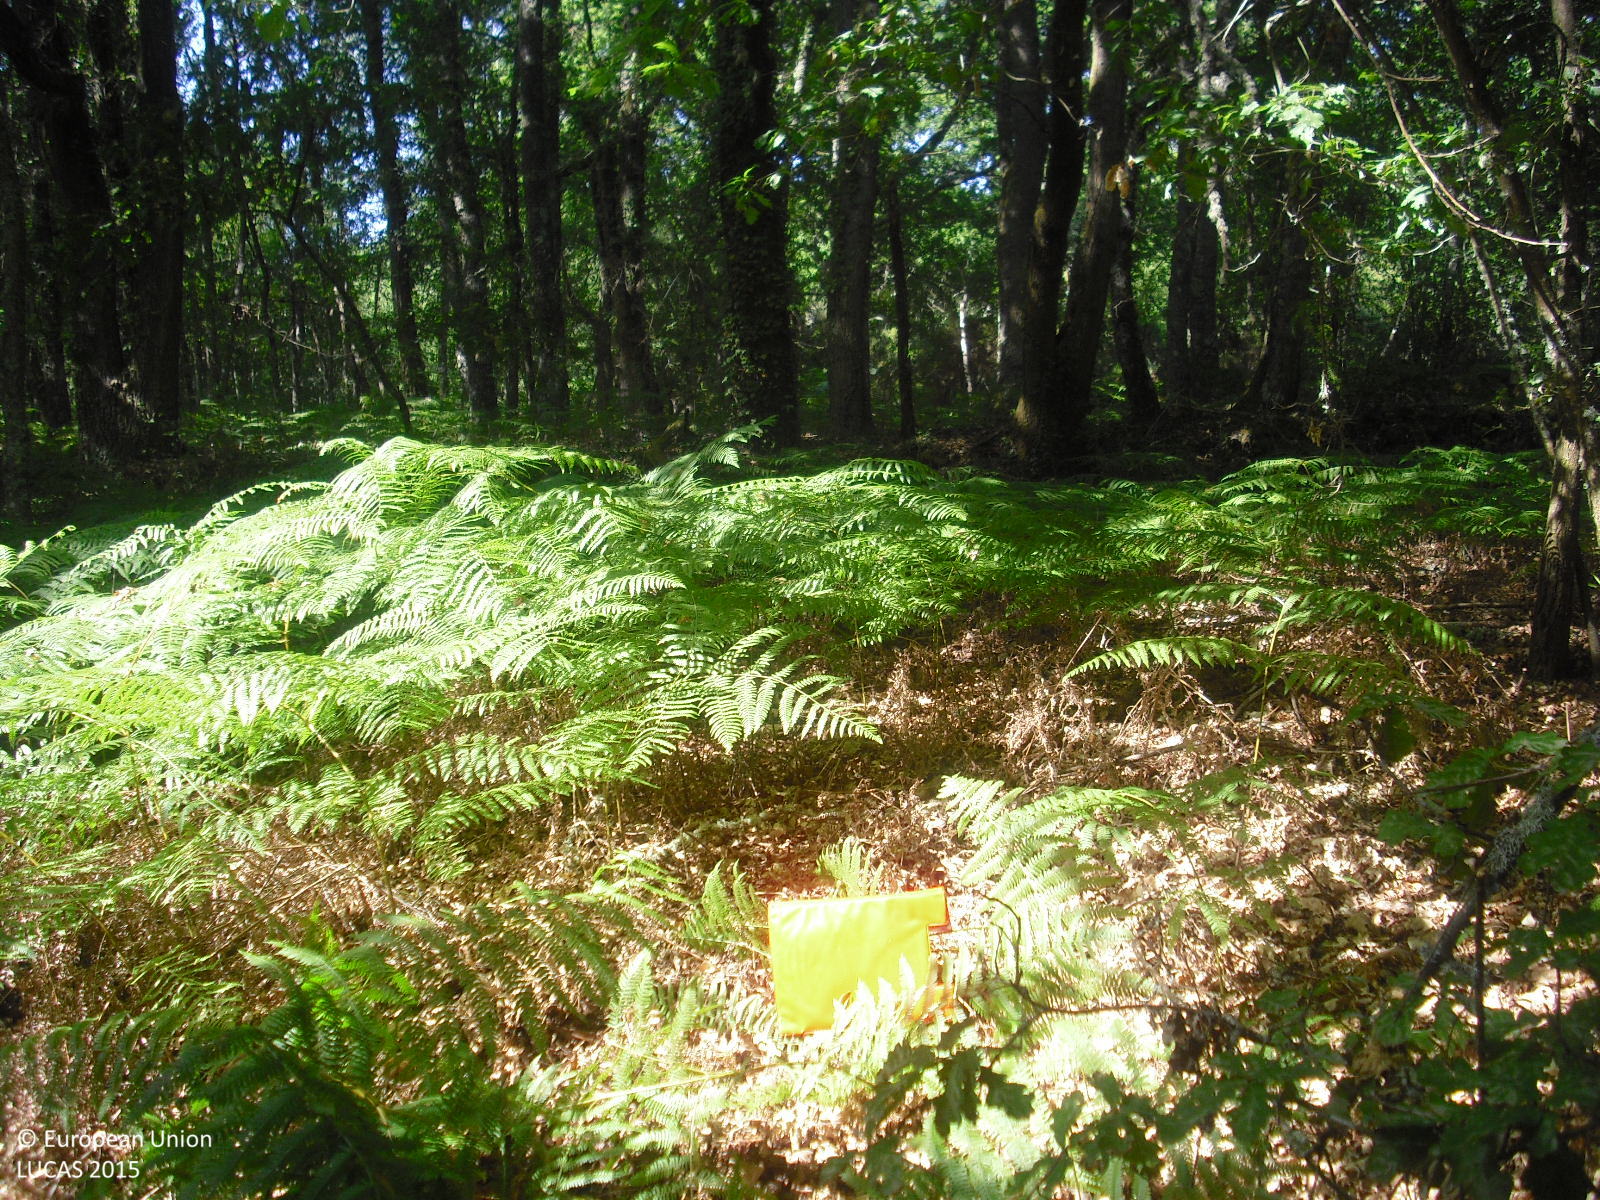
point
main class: Woodland
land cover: Broadleaved woodland
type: thermophilous deciduous forest
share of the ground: 50 - 75 %
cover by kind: broadleaved forest trees 70 %, shrubs 30 %
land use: Forestry
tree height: > 5 m
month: July
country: ES
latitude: 42.2942
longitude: -7.7199
